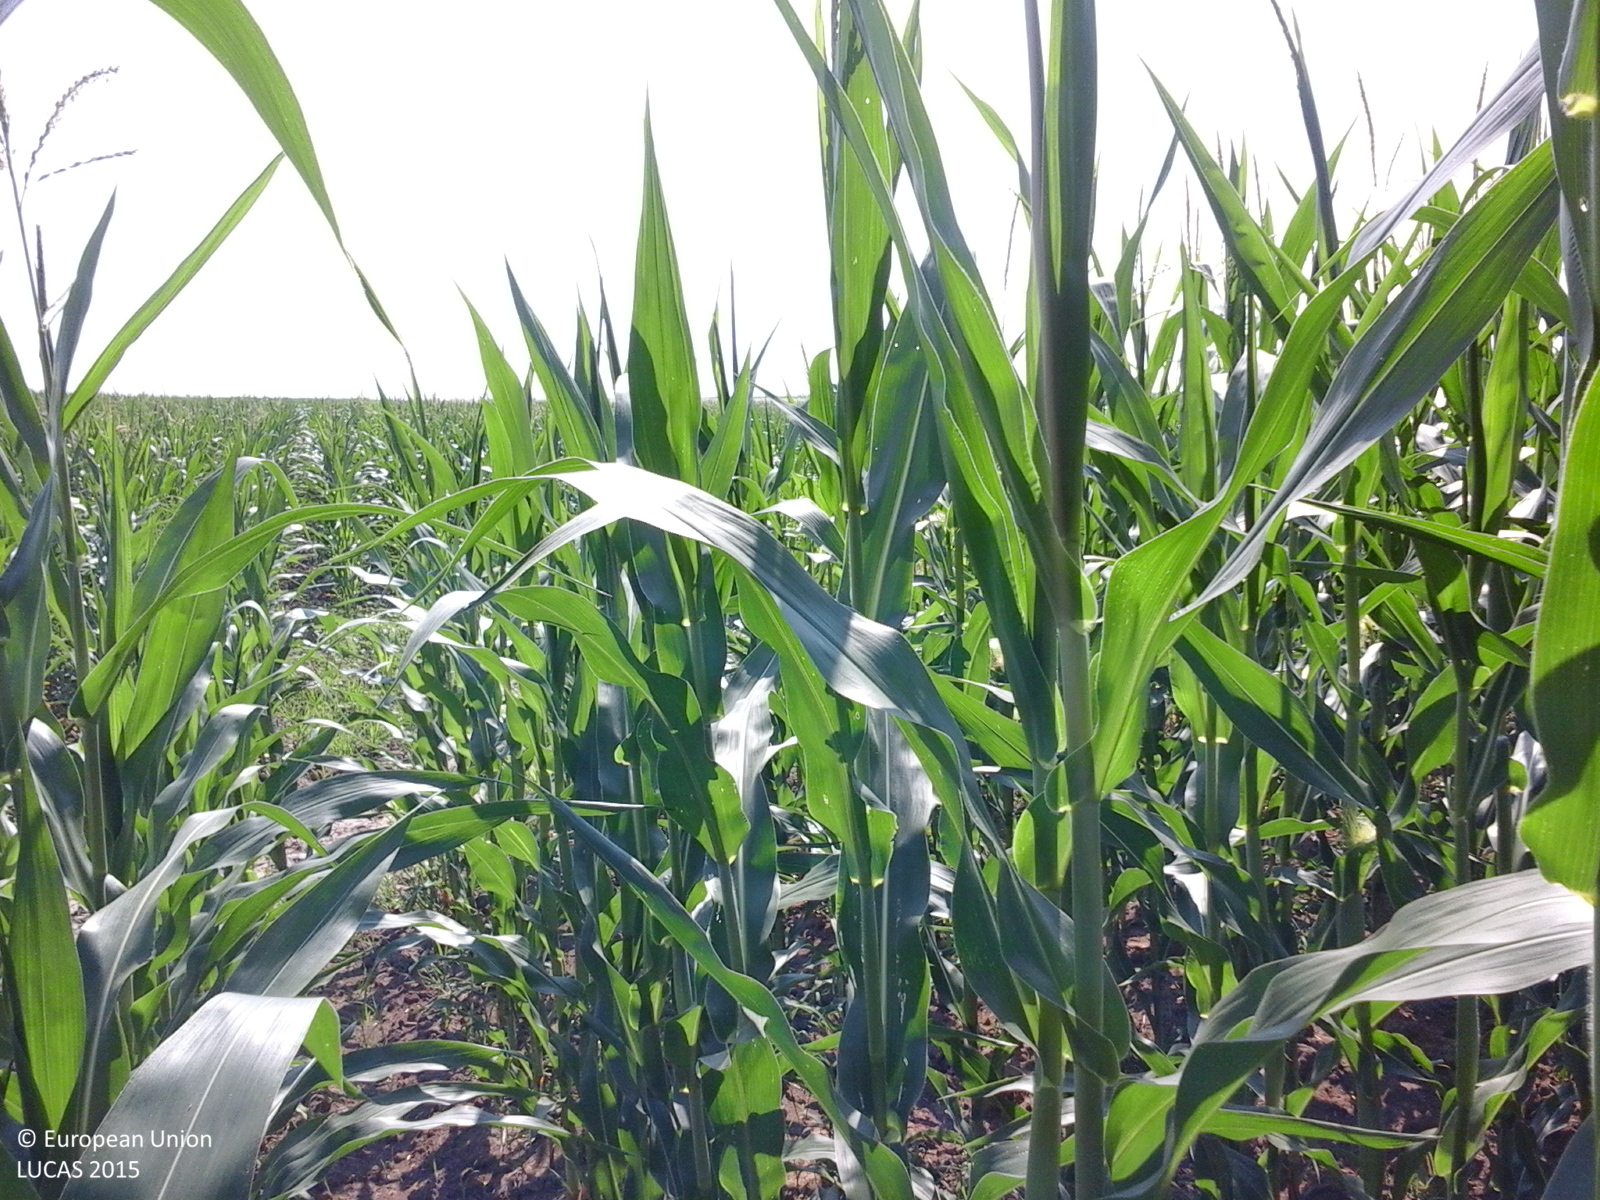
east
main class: Cropland
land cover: Maize
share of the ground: > 75 %
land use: Agriculture (excluding fallow land and kitchen gardens)
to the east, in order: Maize; Sunflower; Grassland without tree/shrub cover; Maize
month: July
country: RO
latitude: 44.7805
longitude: 25.4481
